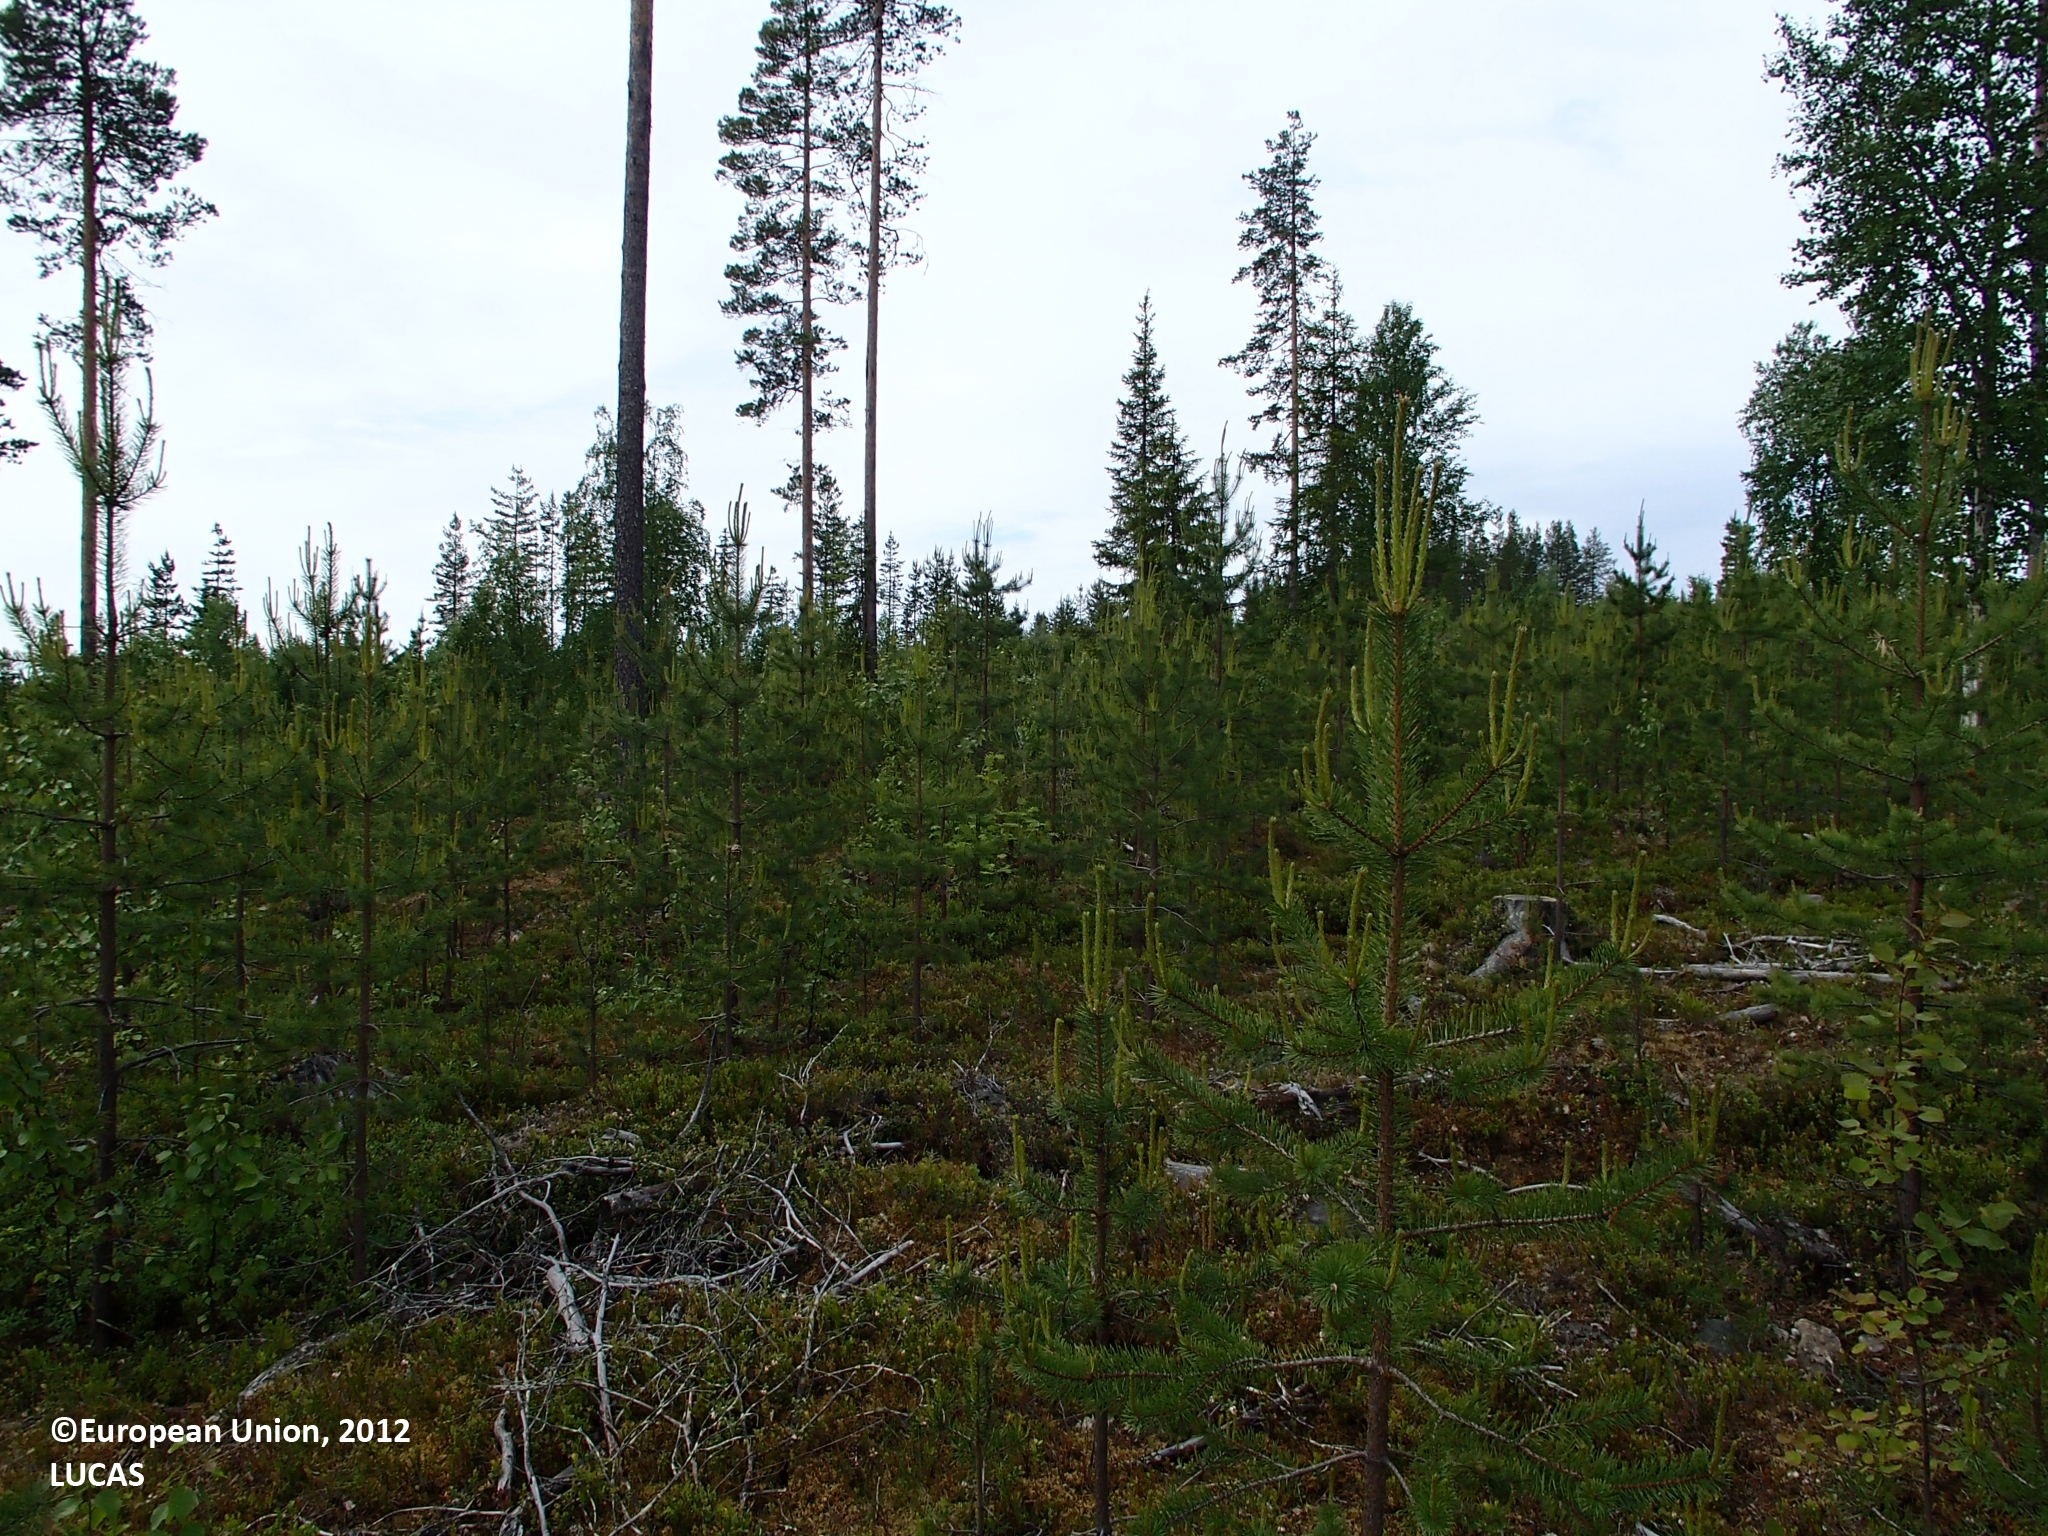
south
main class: Woodland
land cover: Pine dominated coniferous woodland
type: boreal forest
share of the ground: 10 - 25 %
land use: Forestry
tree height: > 5 m
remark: Clear cut
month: June
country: FI
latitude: 66.8218
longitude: 27.5275
